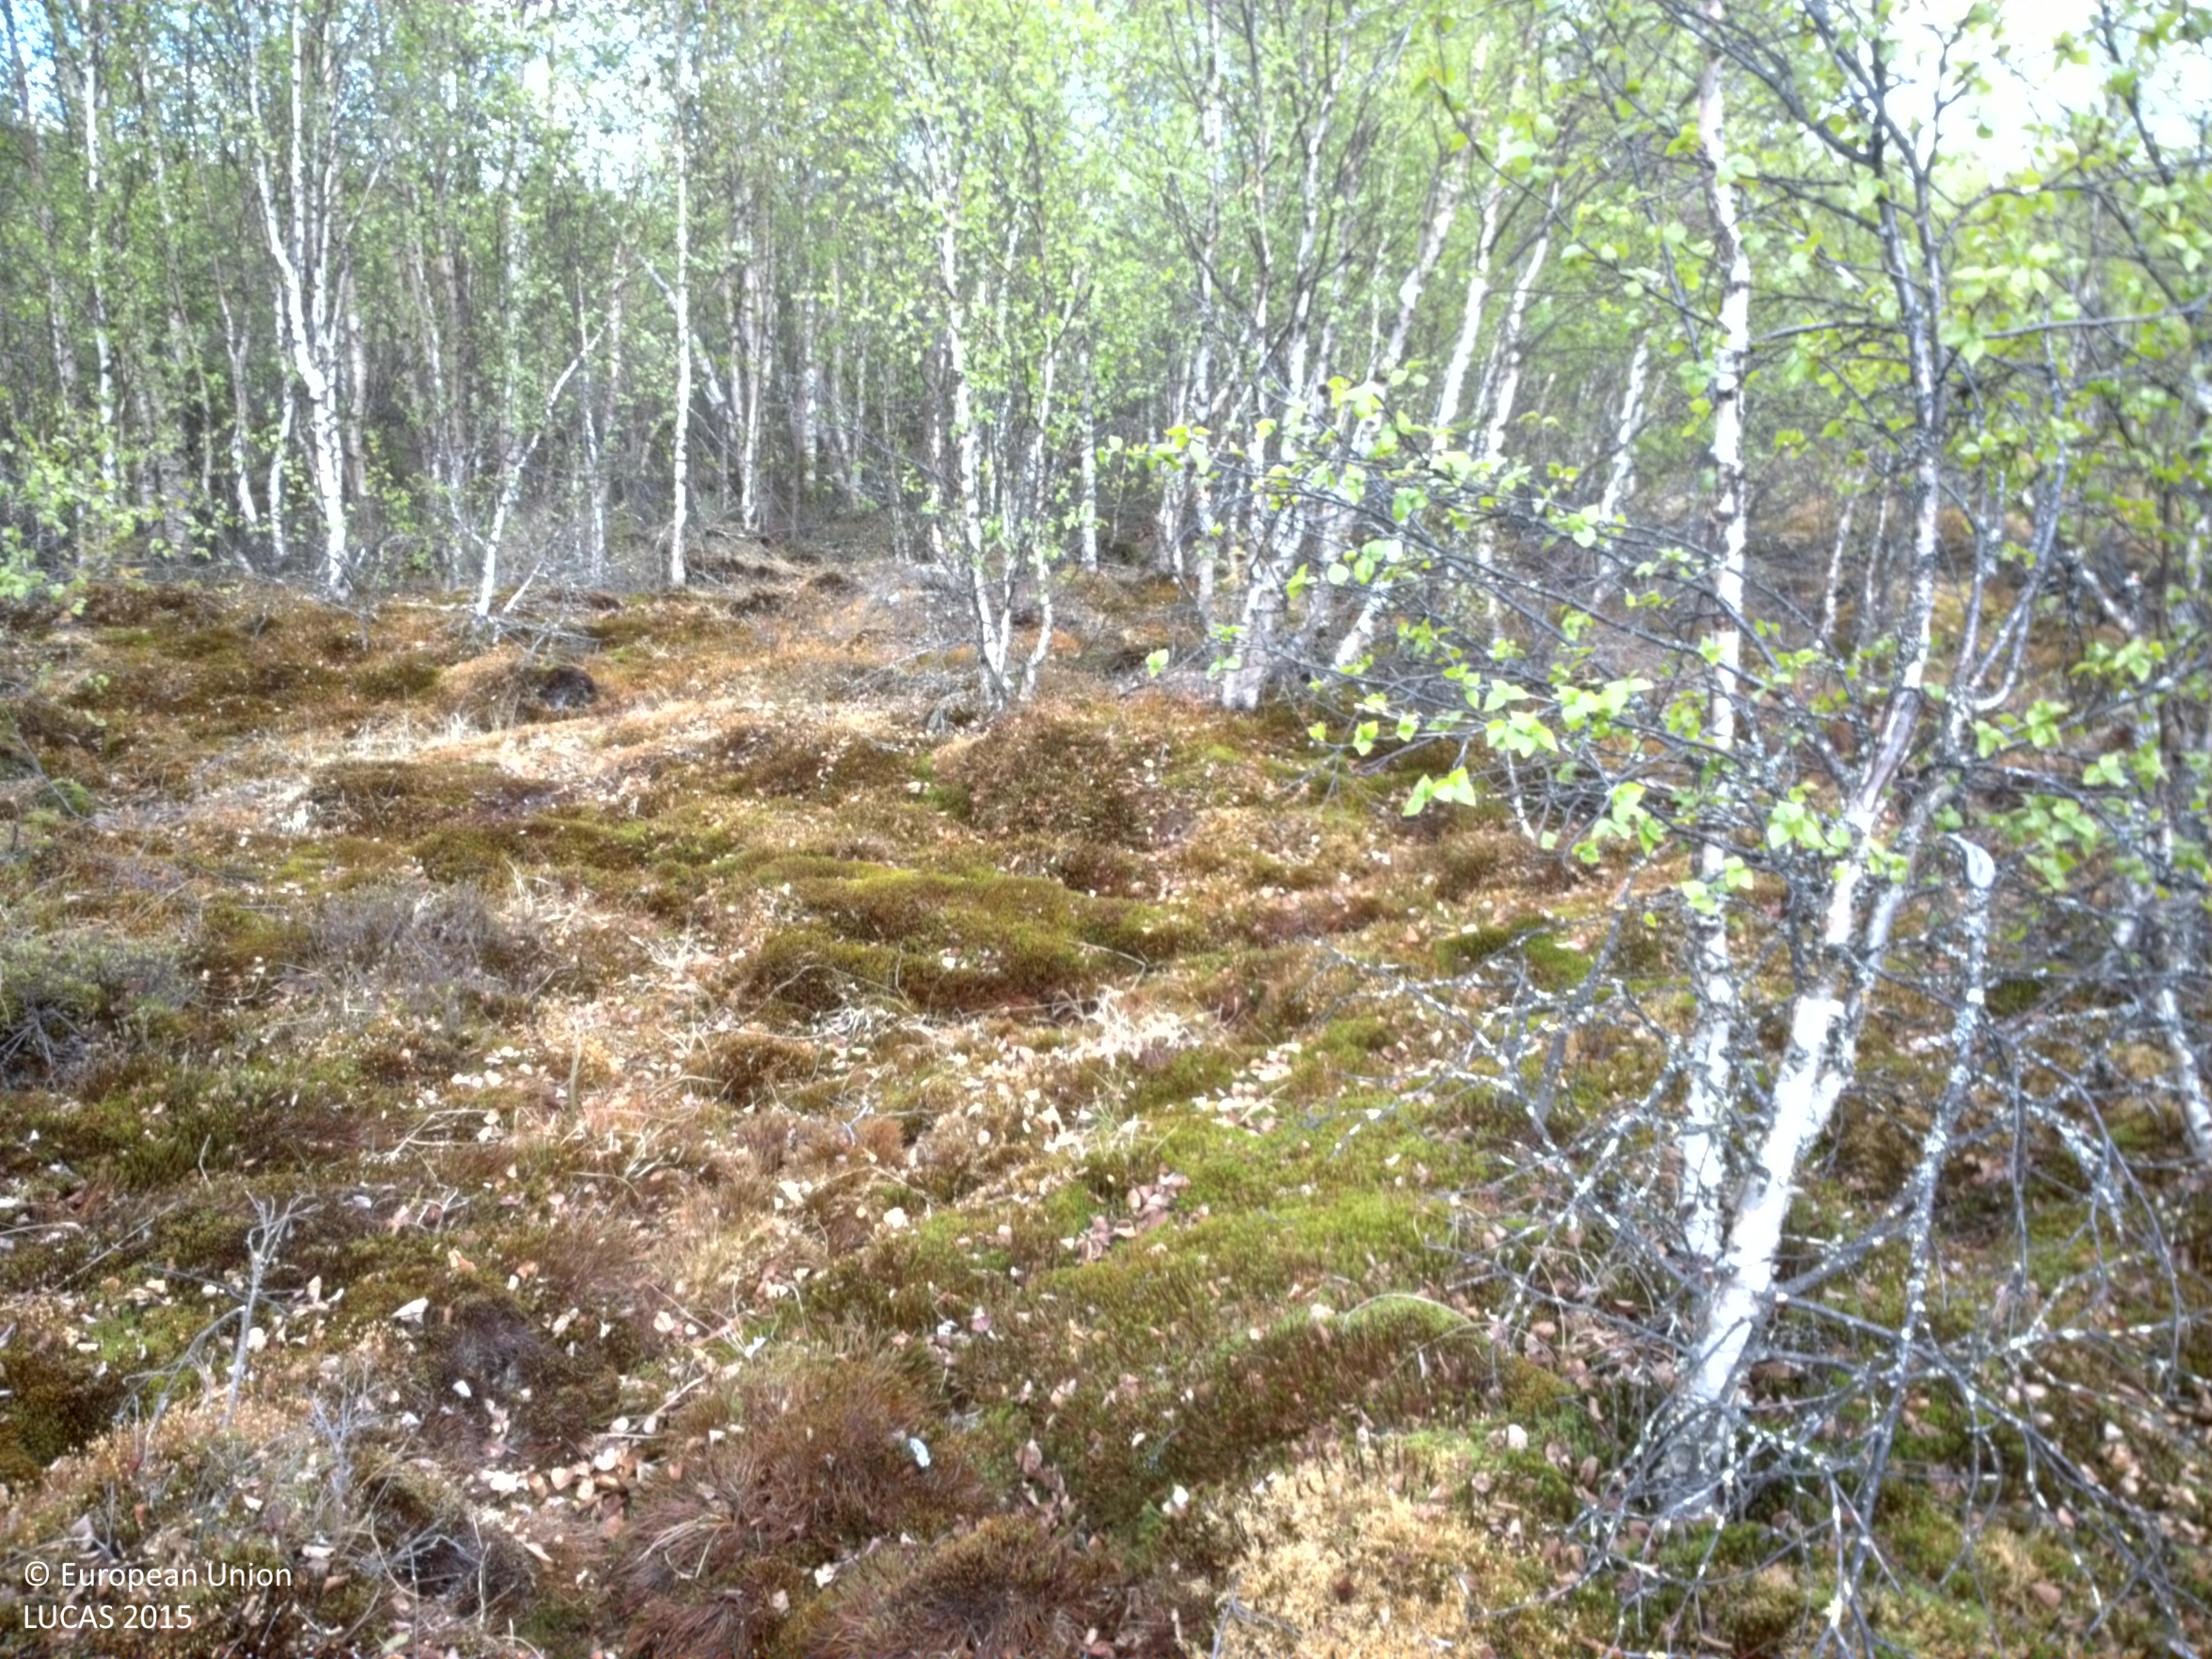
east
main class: Woodland
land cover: Broadleaved woodland
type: boreal forest
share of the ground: 25 - 50 %
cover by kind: lichens and mosses 60 %, broadleaved forest trees 40 %
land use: Forestry
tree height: < 5 m
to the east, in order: Broadleaved woodland; Rivers and streams; Broadleaved woodland; Lichens and moss; Broadleaved woodland; Grassland with sparse tree/shrub cover; Broadleaved woodland; Ditches and canals; Broadleaved woodland; Grassland with sparse tree/shrub cover; Broadleaved woodland; Ditches and canals; Broadleaved woodland; Grass margins; Paved roads, cycling and walking lanes; Other bare soil
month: June
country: SE
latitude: 66.9034
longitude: 21.5857
